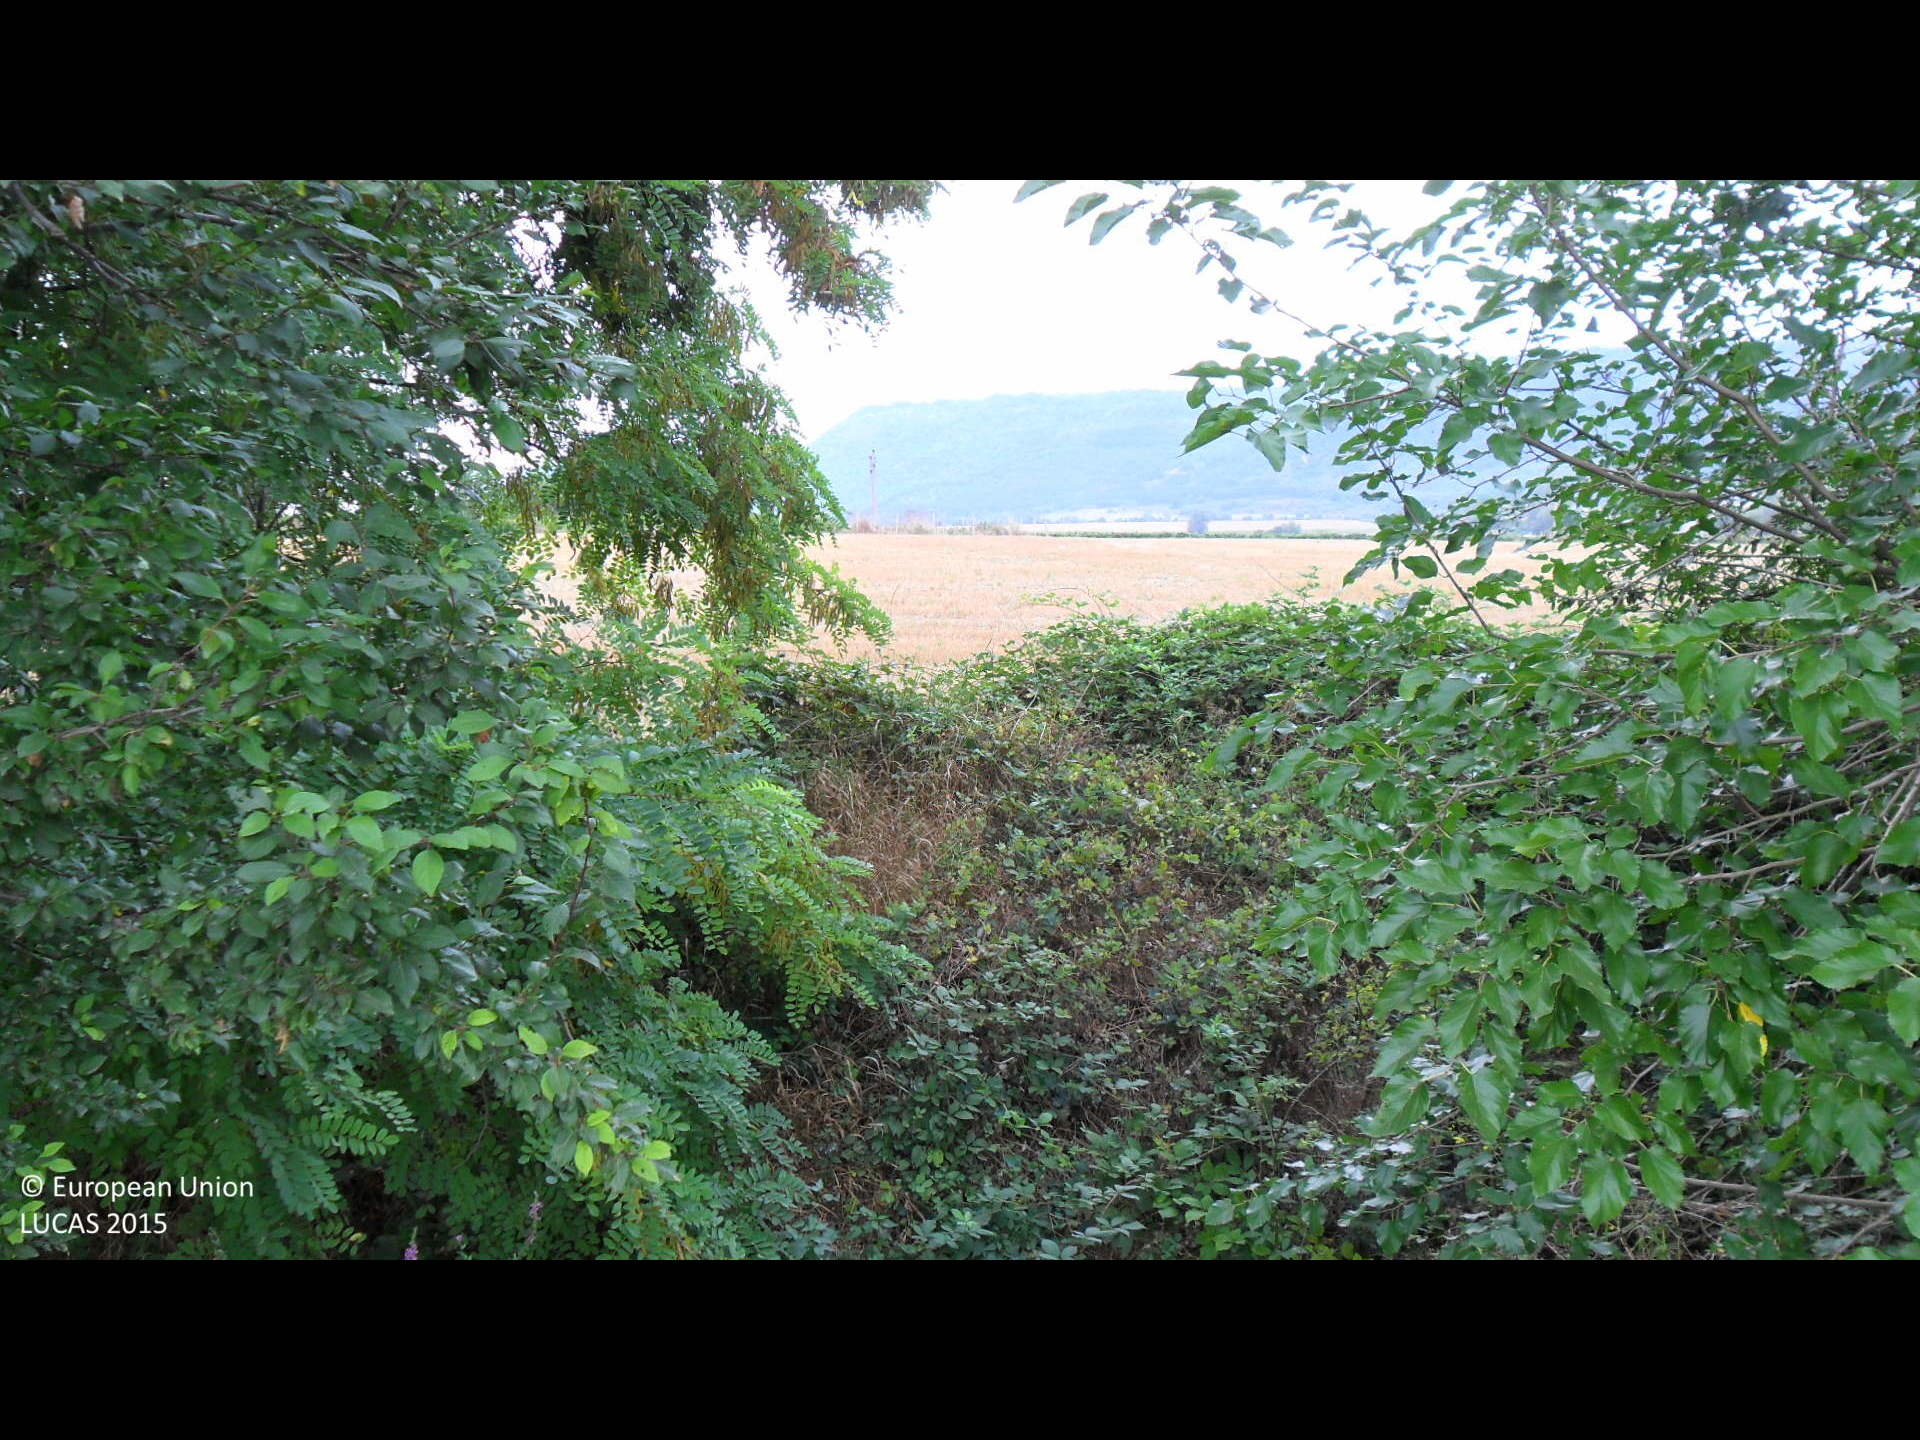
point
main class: Shrubland
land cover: Shrubland with sparse tree cover
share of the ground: > 75 %
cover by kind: shrubs 95 %, broadleaved forest trees 5 %
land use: Semi-natural and natural areas not in use
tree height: < 5 m
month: August
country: BG
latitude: 43.4571
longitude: 26.1750
